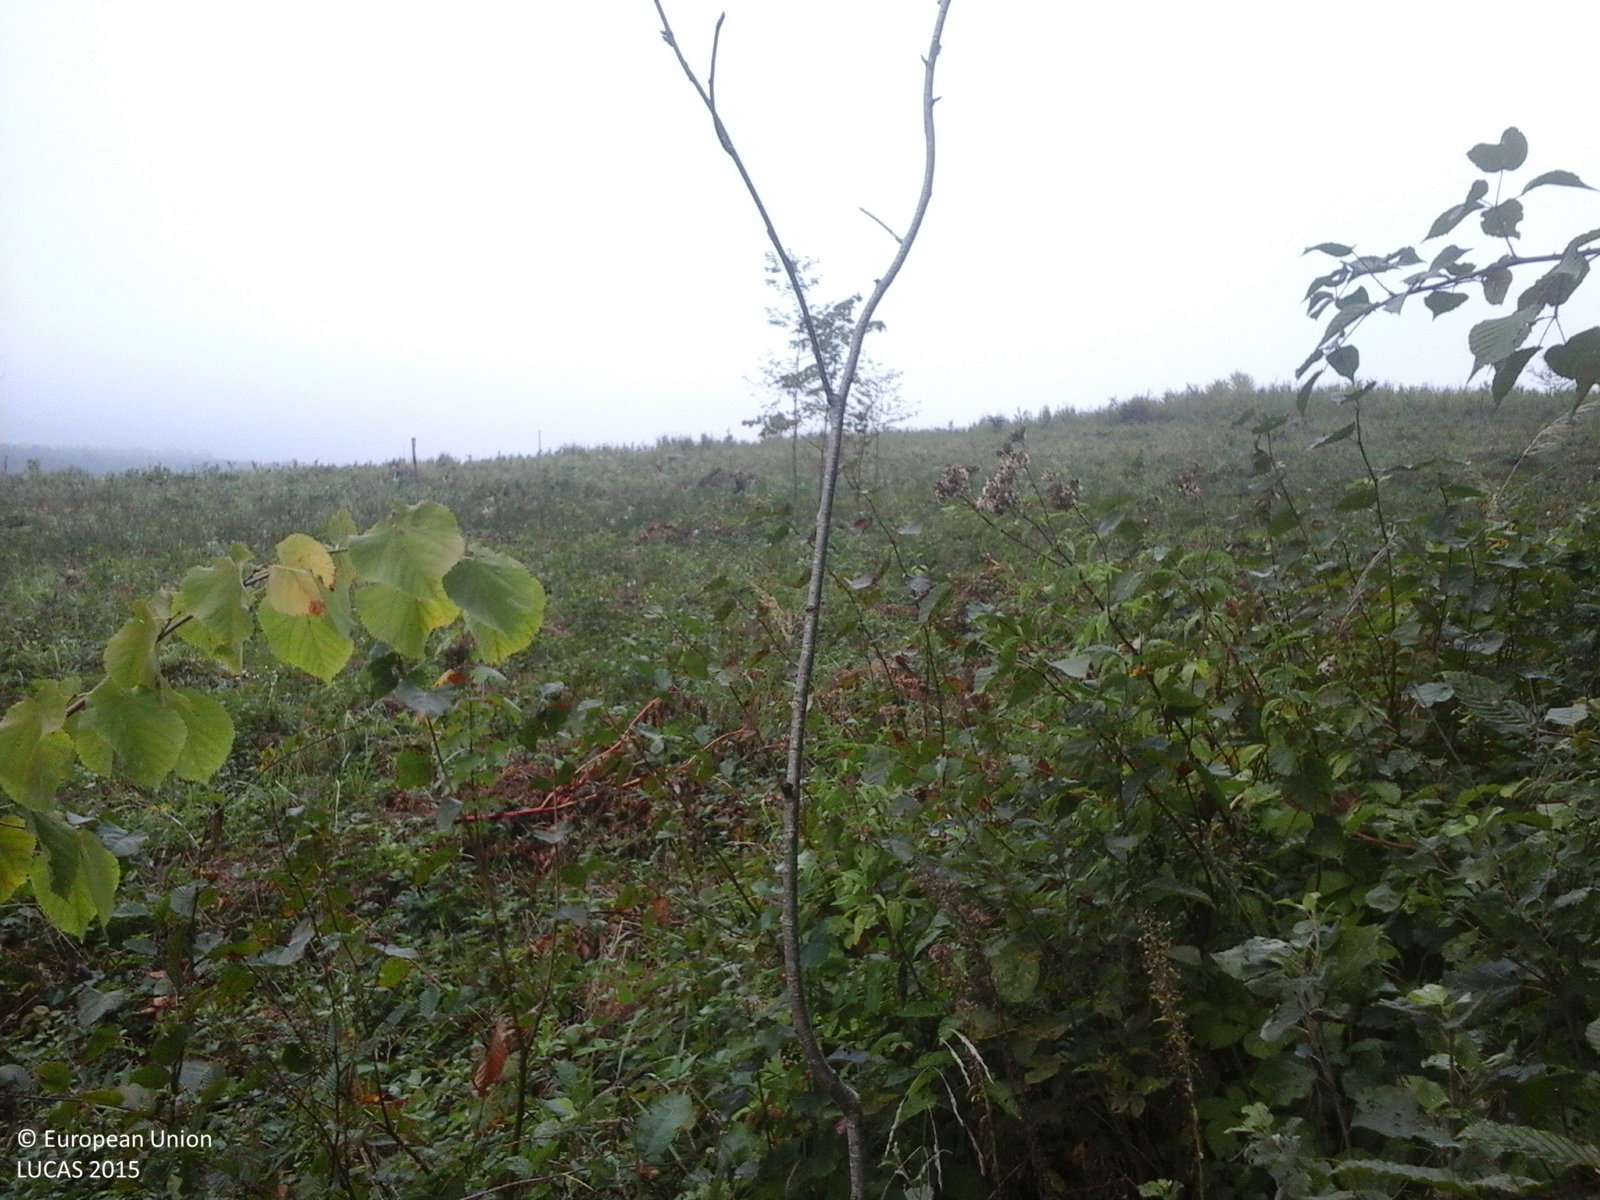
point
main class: Shrubland
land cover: Shrubland without tree cover
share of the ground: > 75 %
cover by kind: shrubs 100 %
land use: Forestry
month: September
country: RO
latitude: 45.7600
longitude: 22.1925
